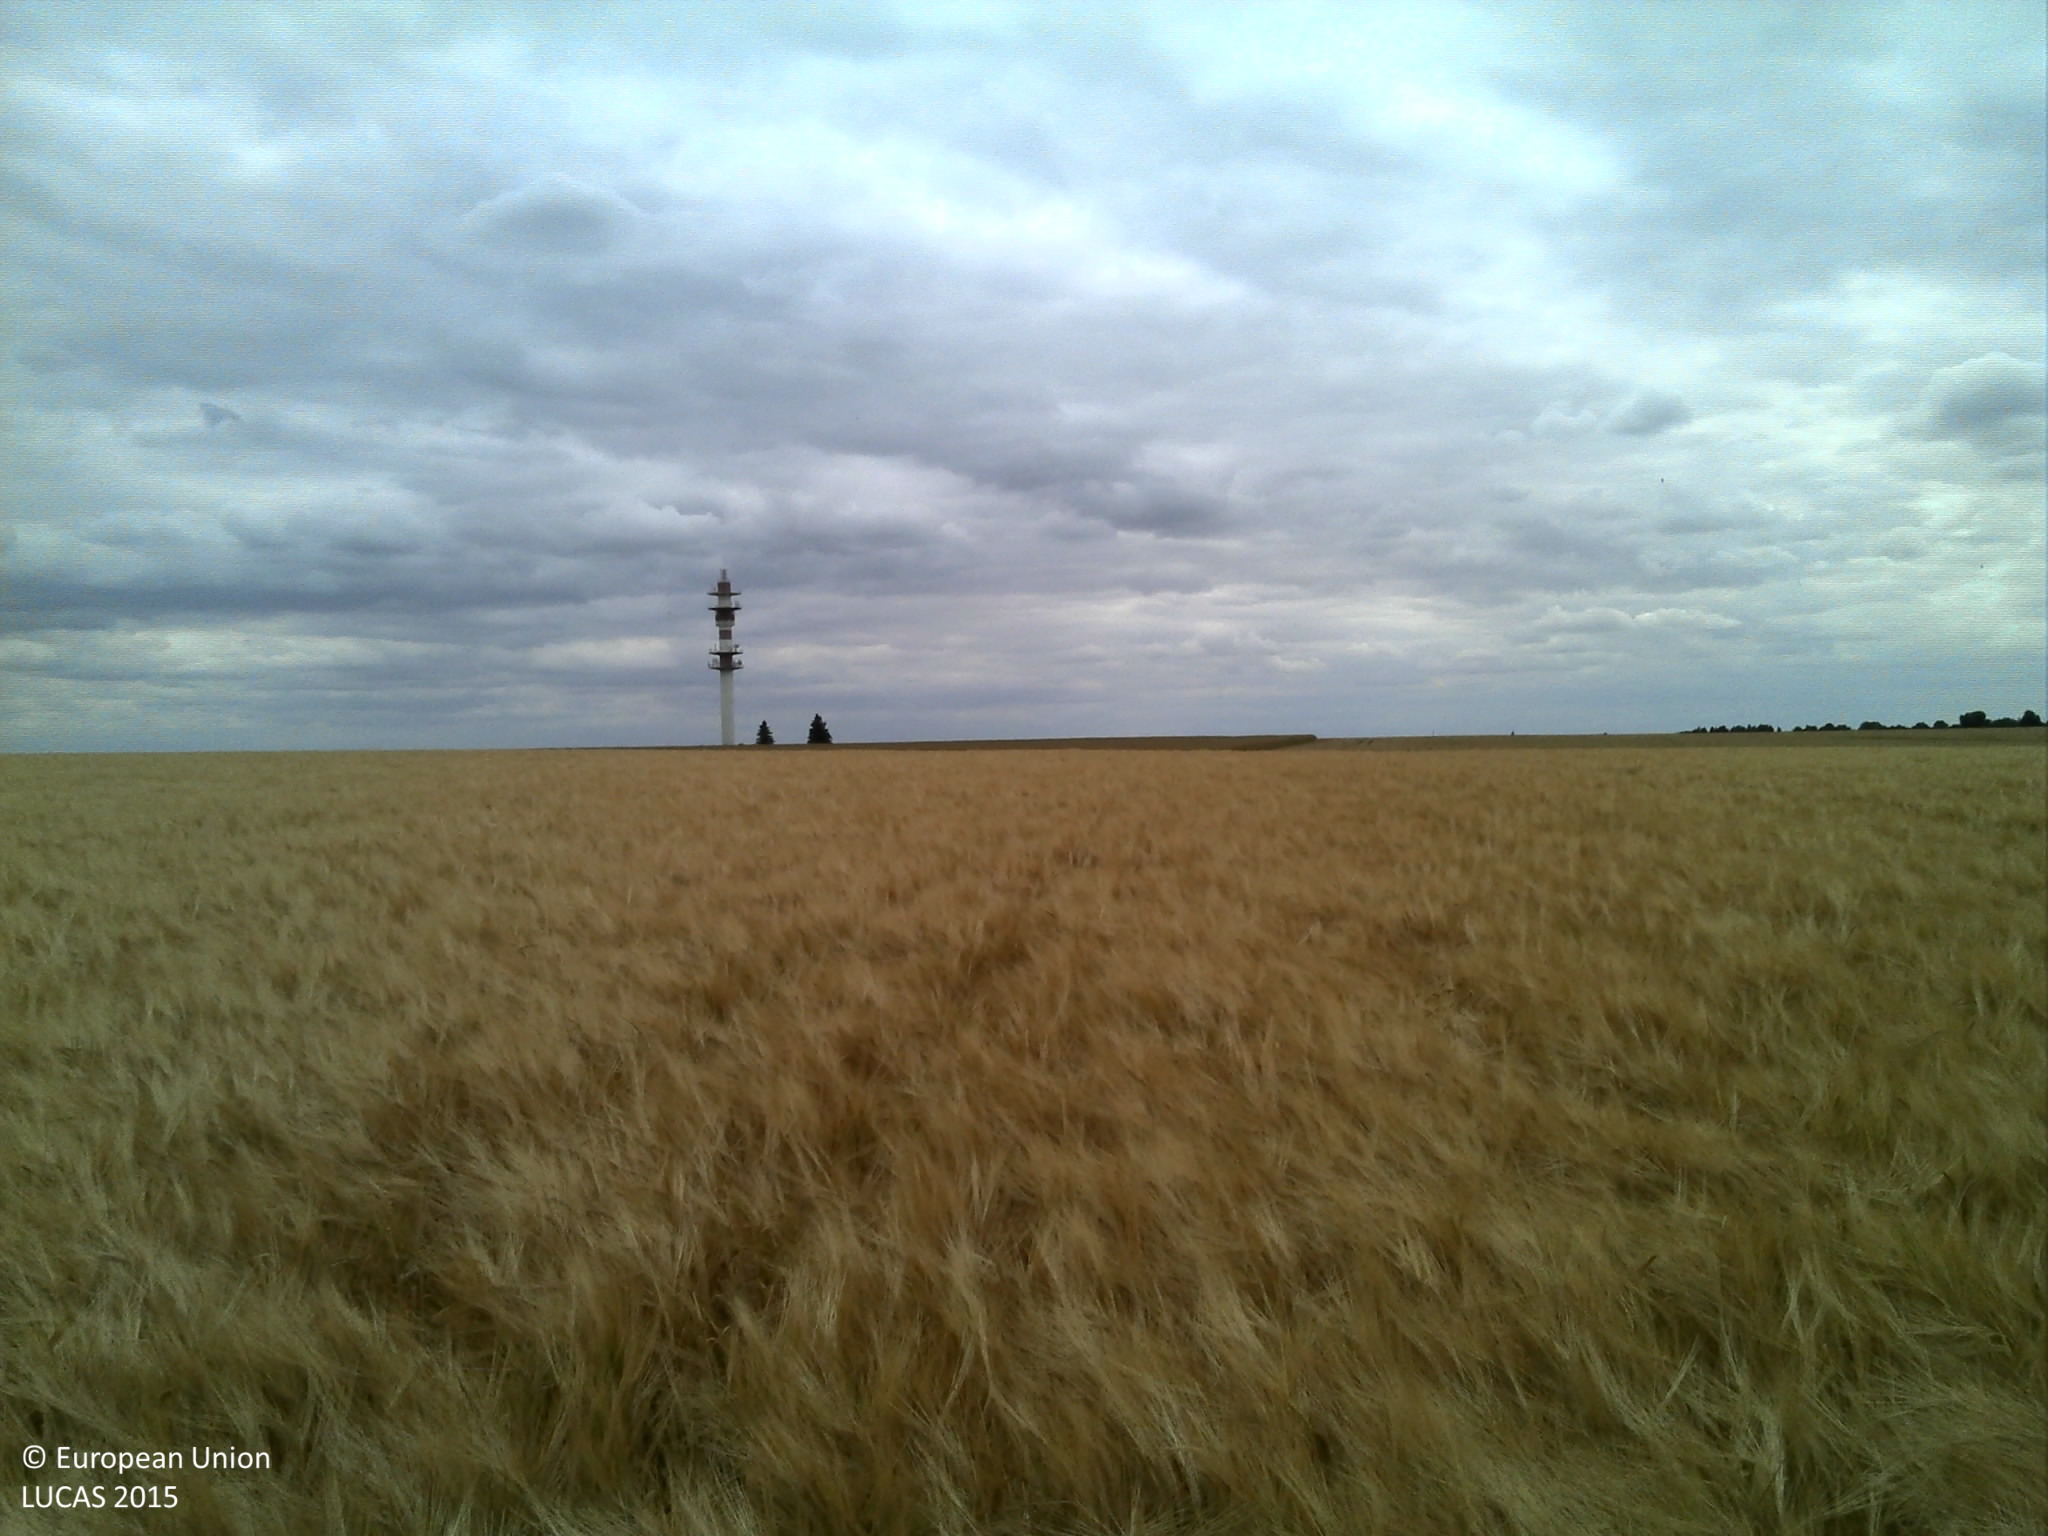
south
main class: Cropland
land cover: Barley
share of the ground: > 75 %
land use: Agriculture (excluding fallow land and kitchen gardens)
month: July
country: FR
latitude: 48.4868
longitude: 2.4256
